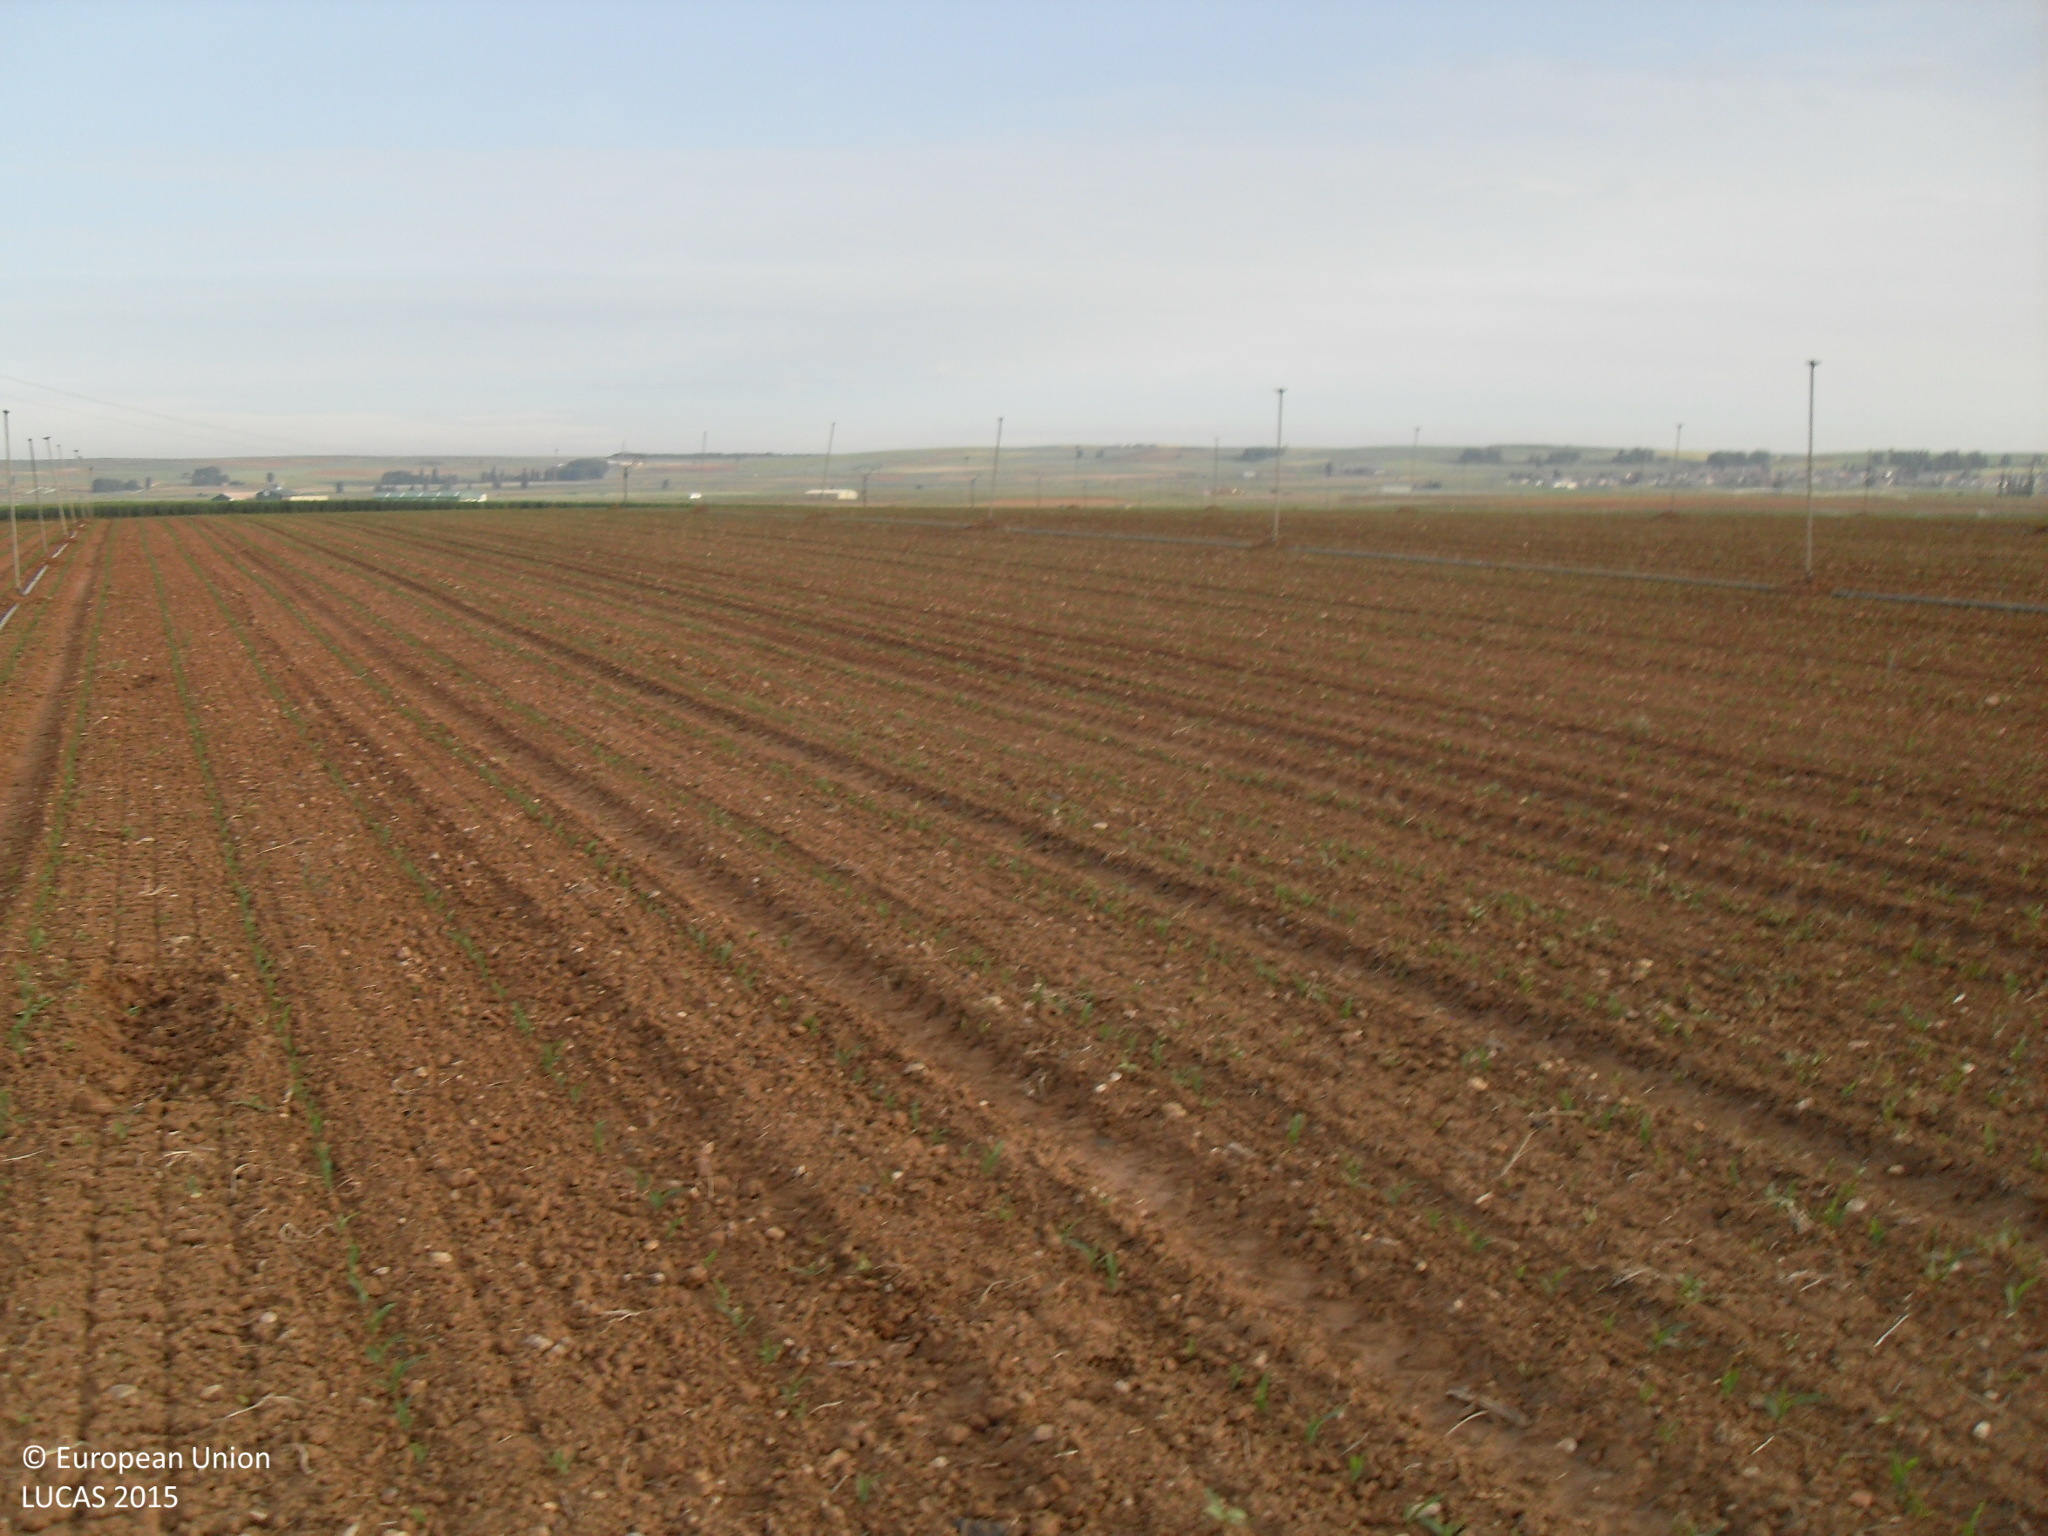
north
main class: Cropland
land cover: Maize
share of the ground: > 75 %
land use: Agriculture (excluding fallow land and kitchen gardens)
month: May
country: ES
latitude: 40.9739
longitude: -5.3903
